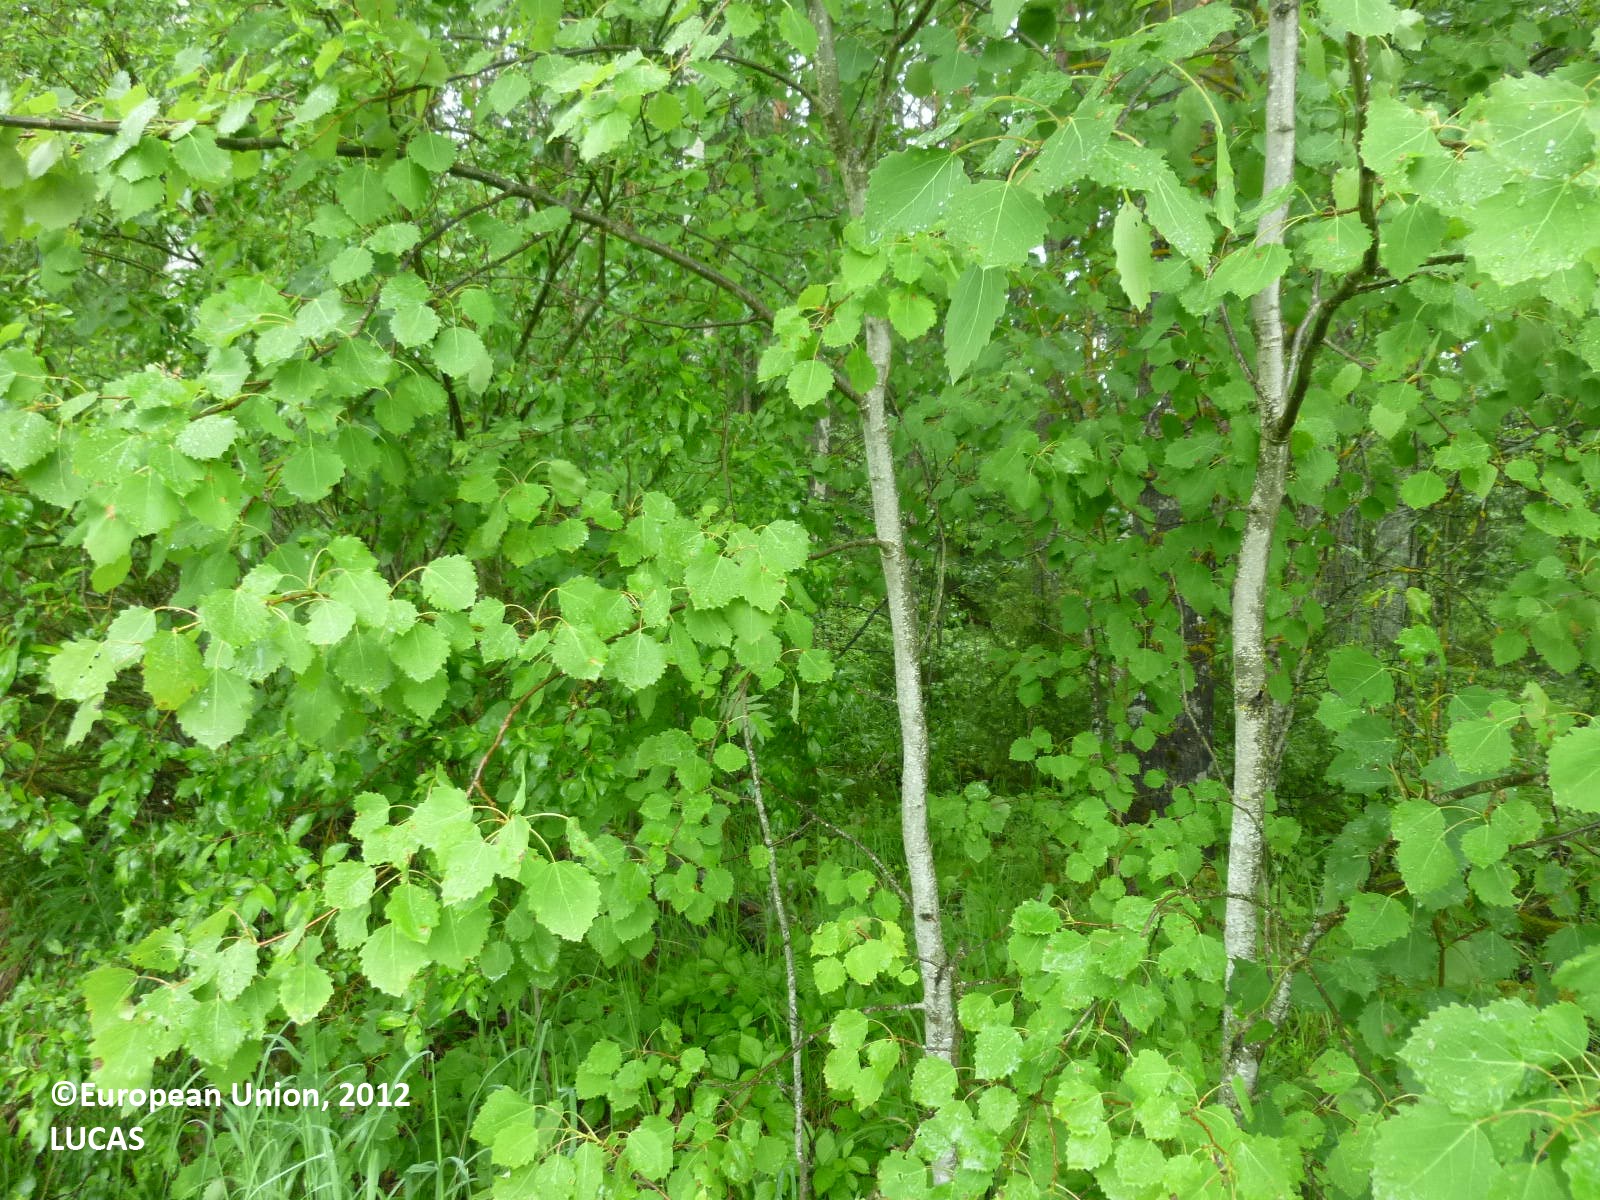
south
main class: Cropland
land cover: Barley
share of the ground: > 75 %
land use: Agriculture (excluding fallow land and kitchen gardens)
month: June
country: FI
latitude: 61.6094
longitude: 22.3335
